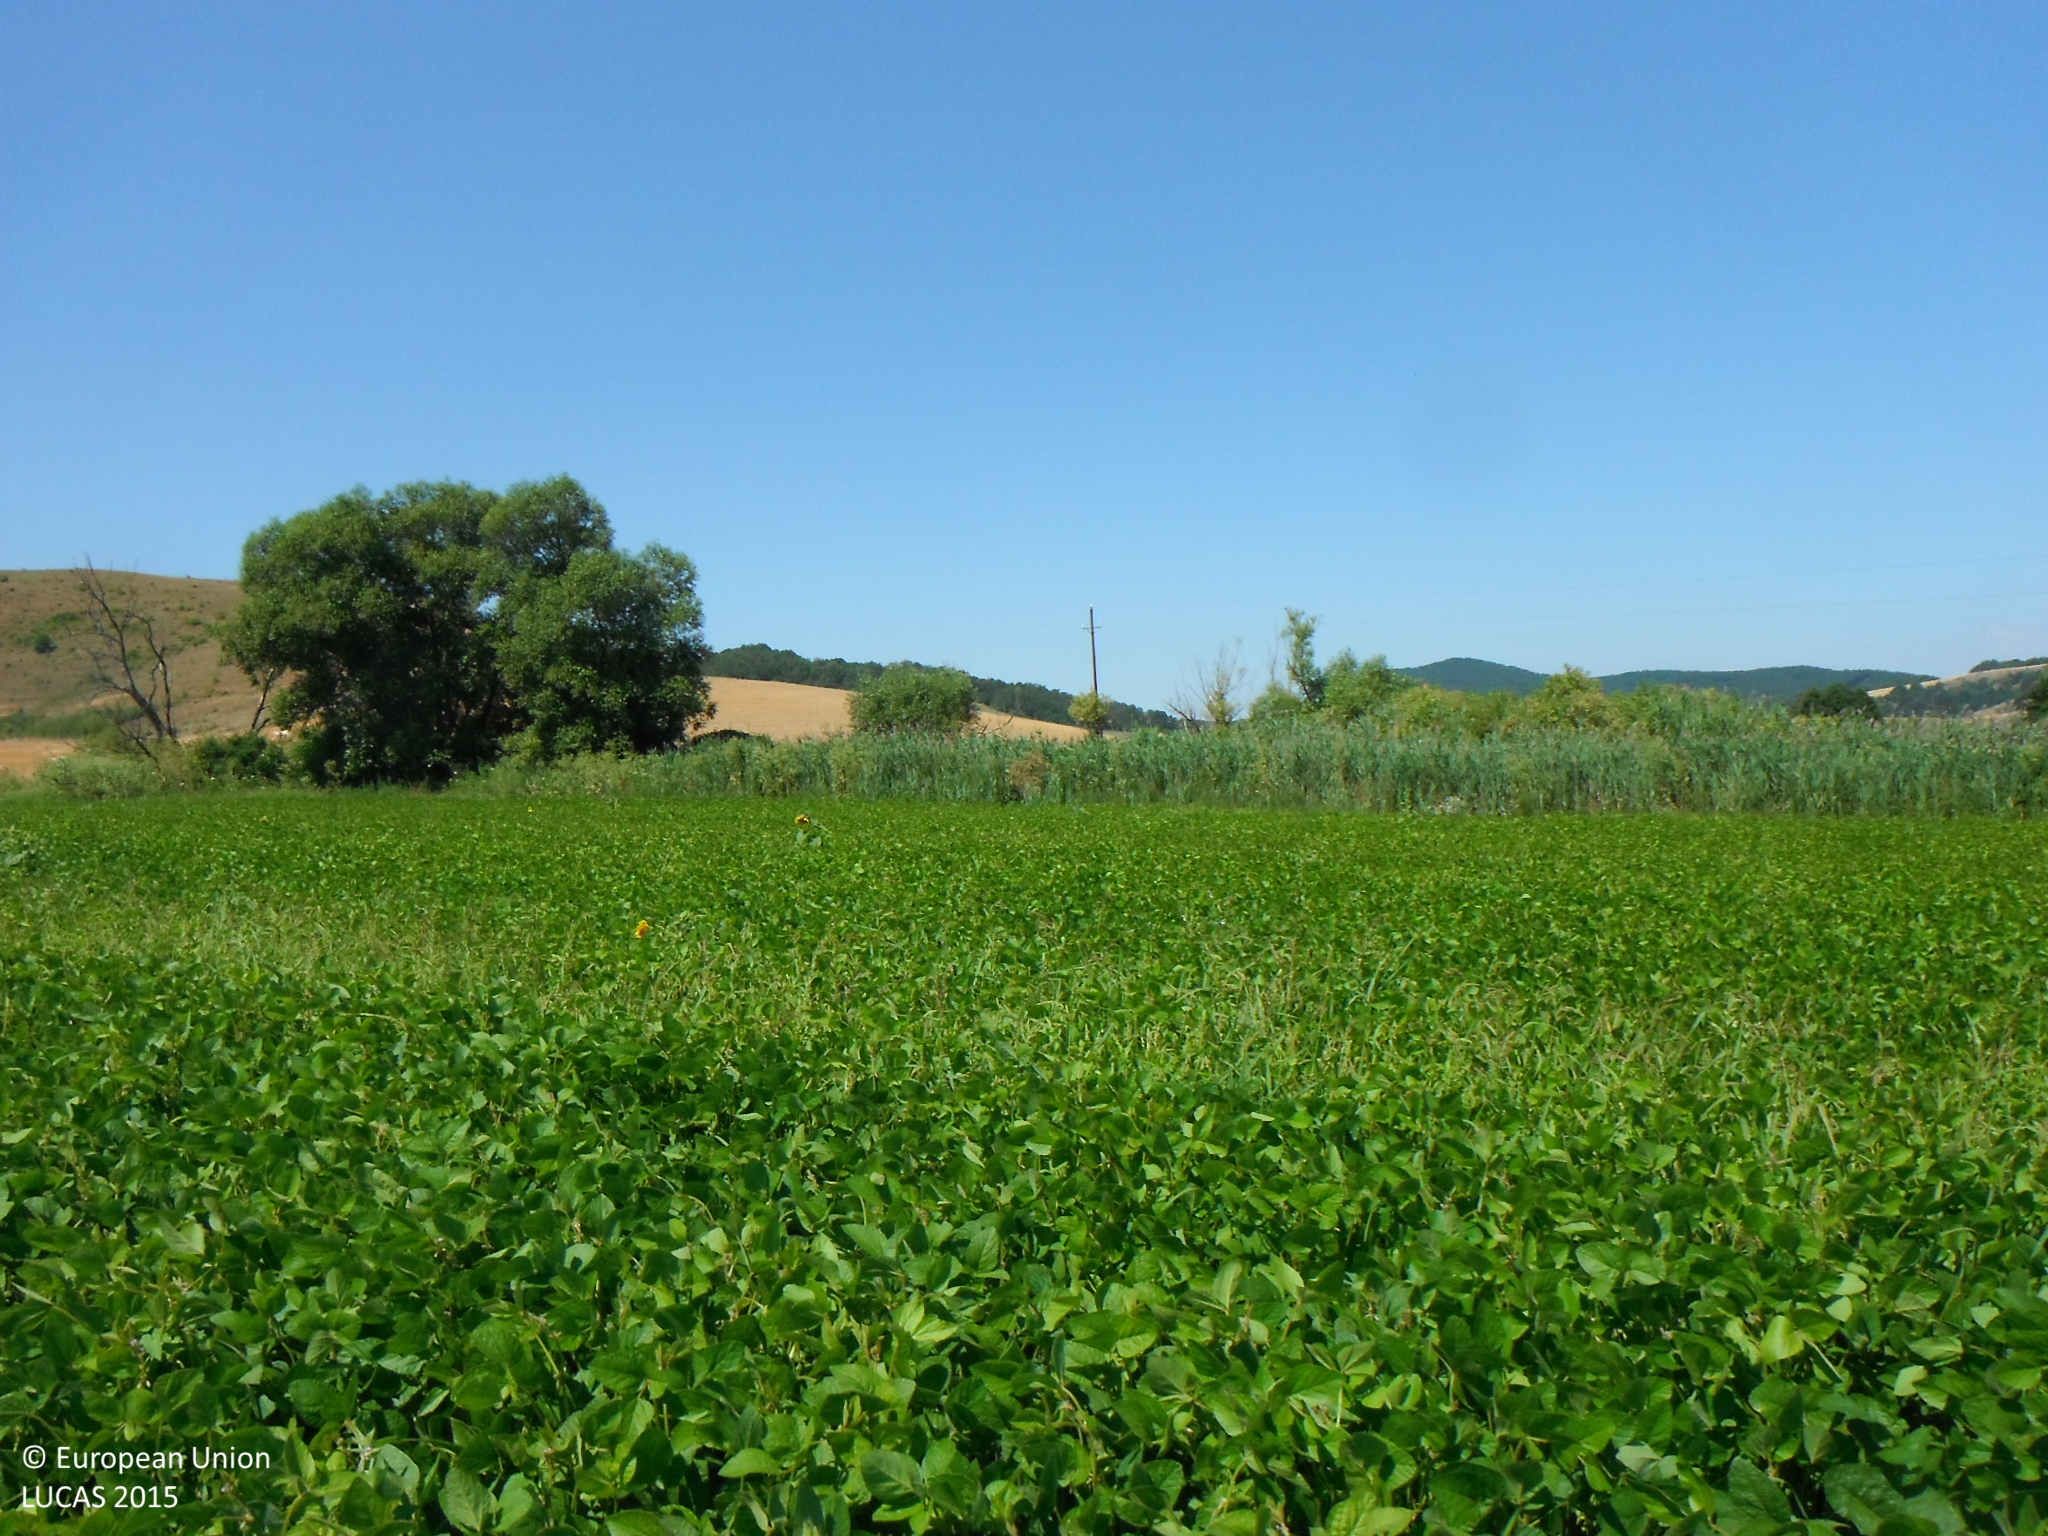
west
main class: Cropland
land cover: Soya
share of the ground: > 75 %
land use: Agriculture (excluding fallow land and kitchen gardens)
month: July
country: SK
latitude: 48.2361
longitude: 20.0329
